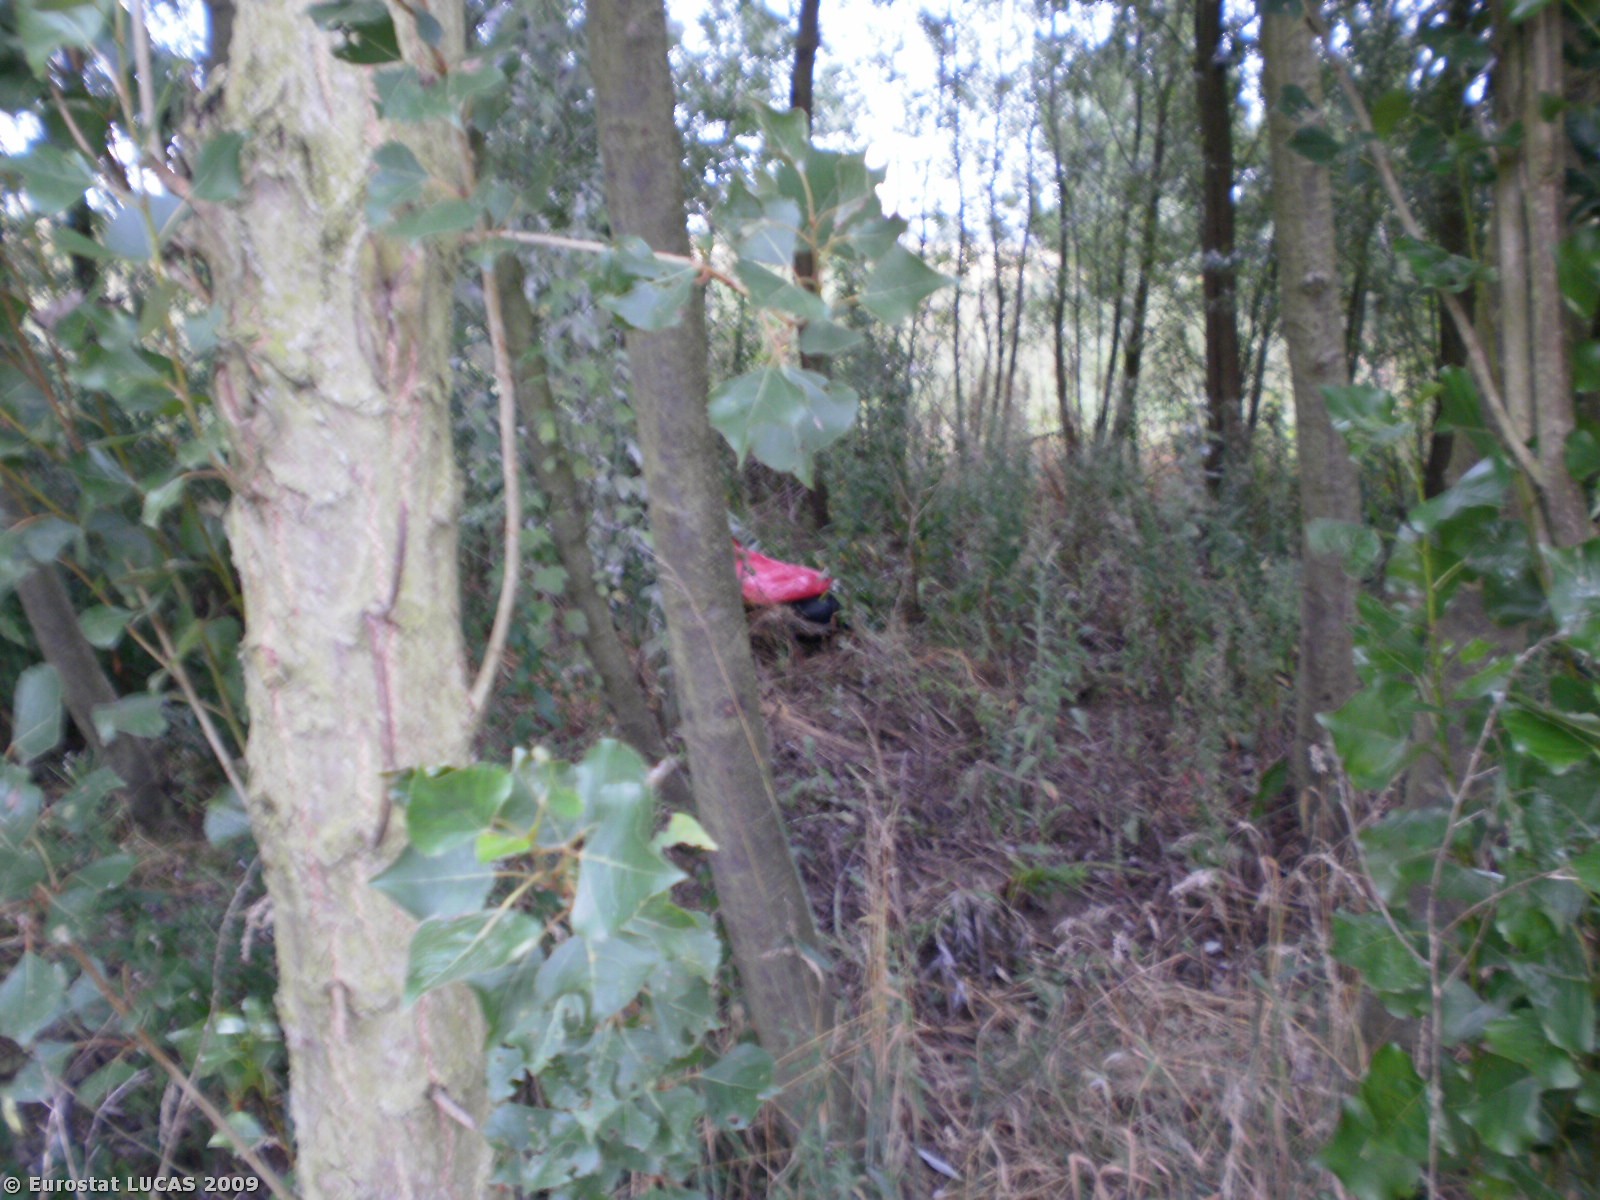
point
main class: Woodland
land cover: Broadleaved woodland
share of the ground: > 75 %
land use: Forestry
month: July
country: BE
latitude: 50.9231
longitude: 4.2619
